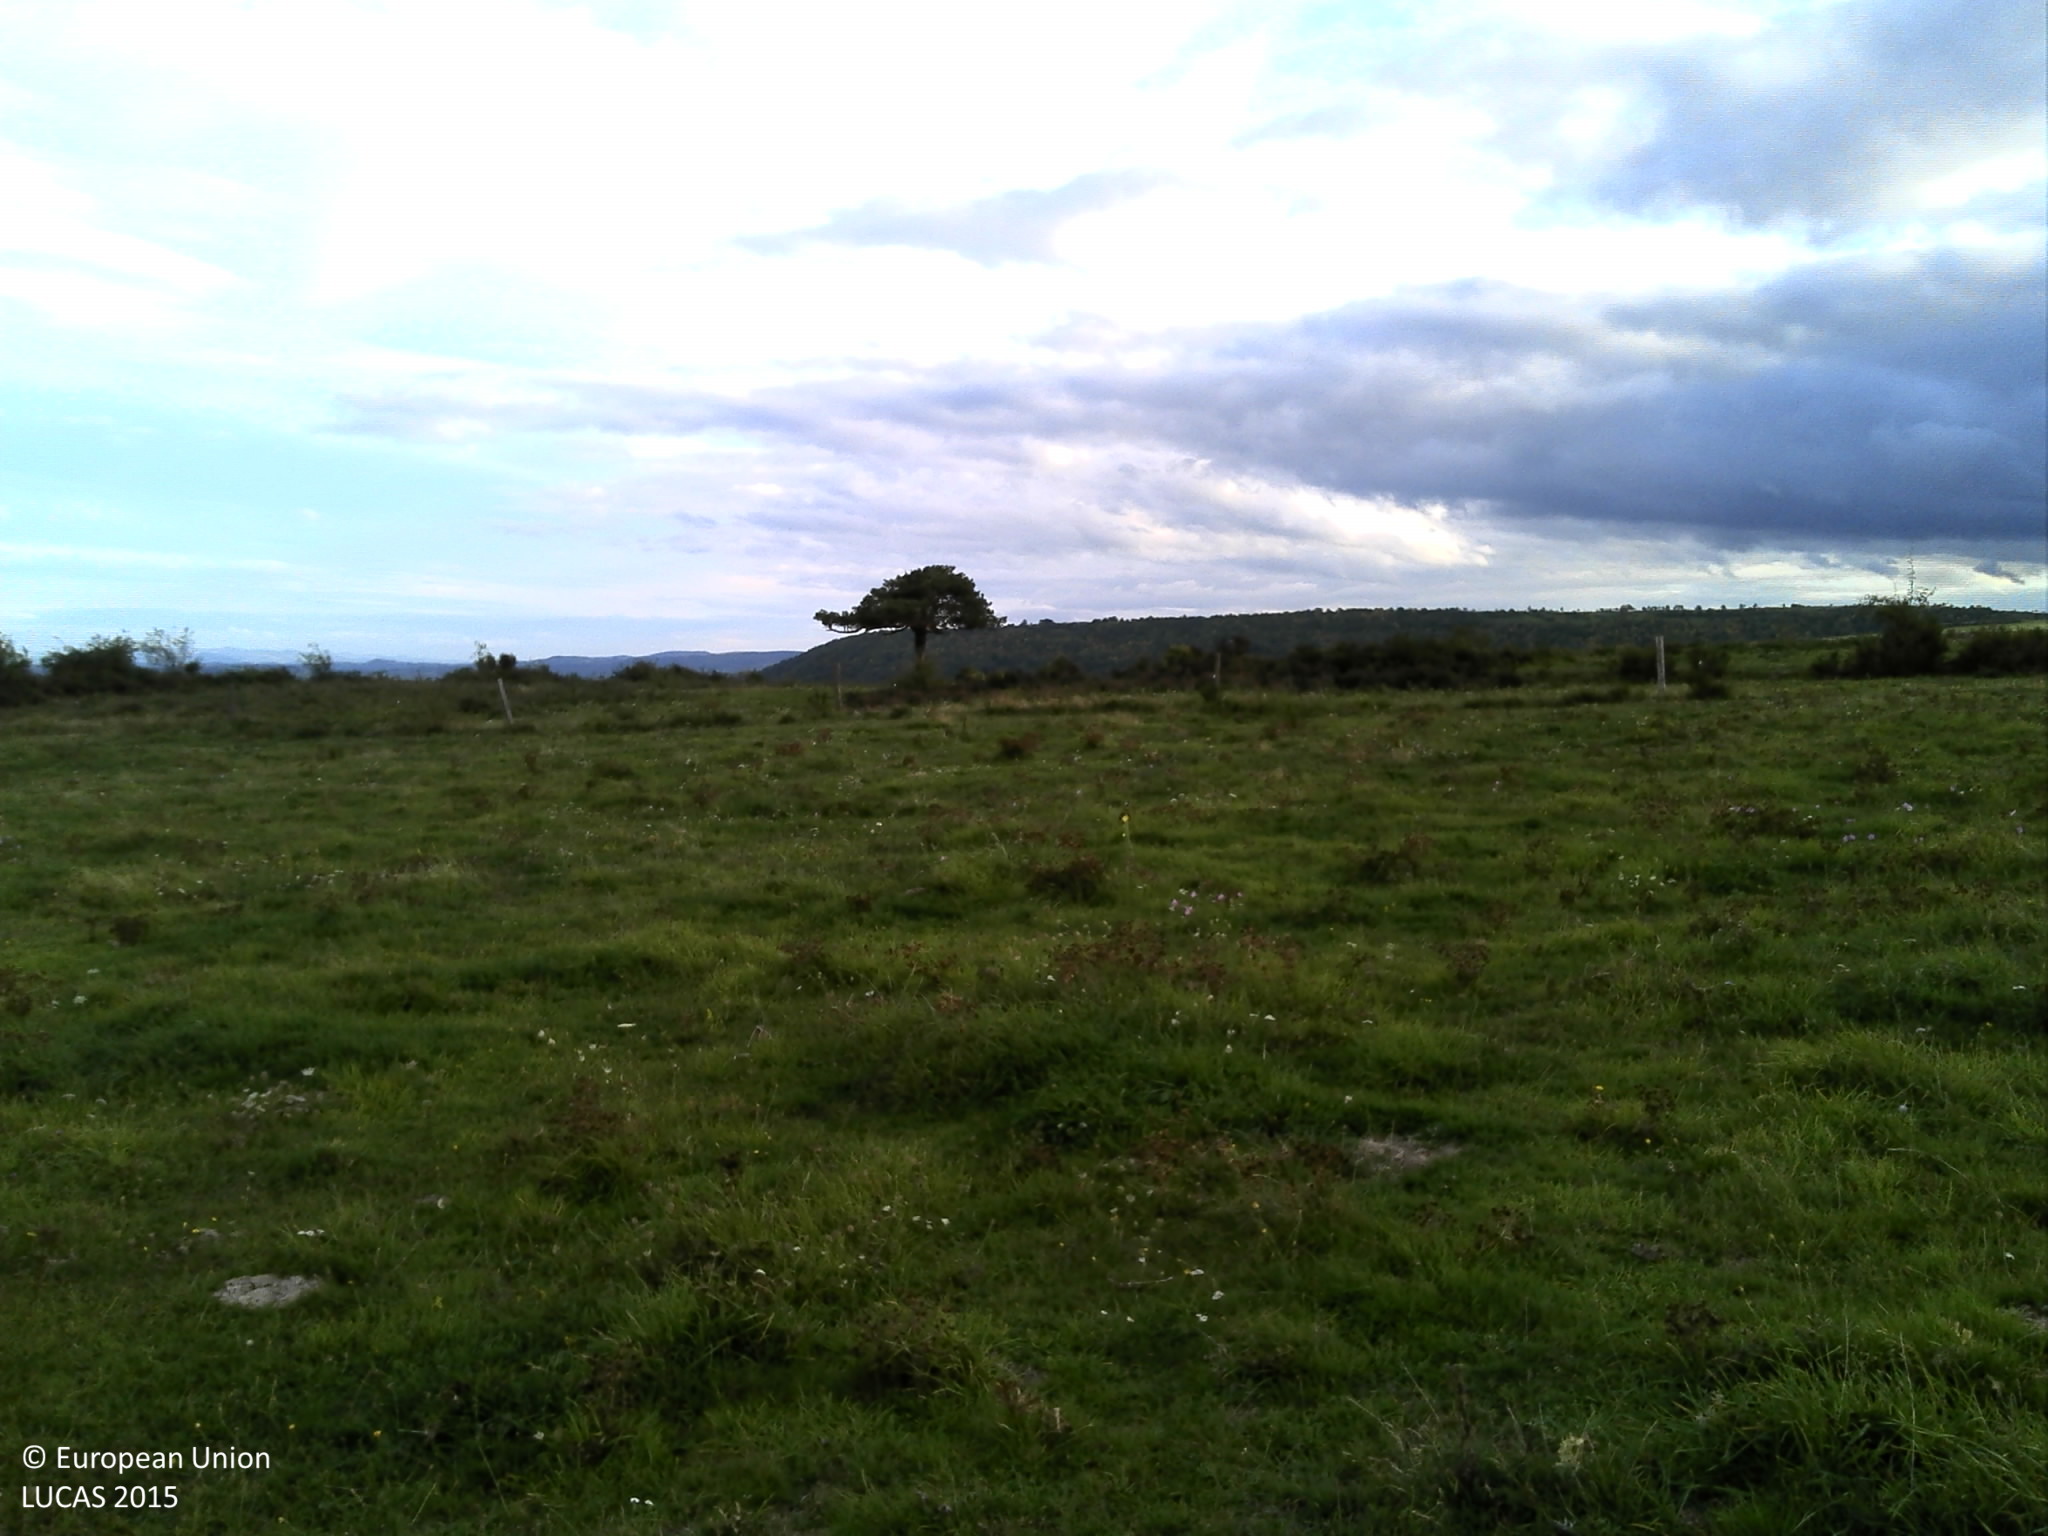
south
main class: Grassland
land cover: Grassland without tree/shrub cover
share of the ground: > 75 %
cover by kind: herbaceous plants 100 %
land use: Agriculture (excluding fallow land and kitchen gardens)
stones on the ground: < 10 %
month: October
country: FR
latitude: 45.3719
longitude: 3.1444
